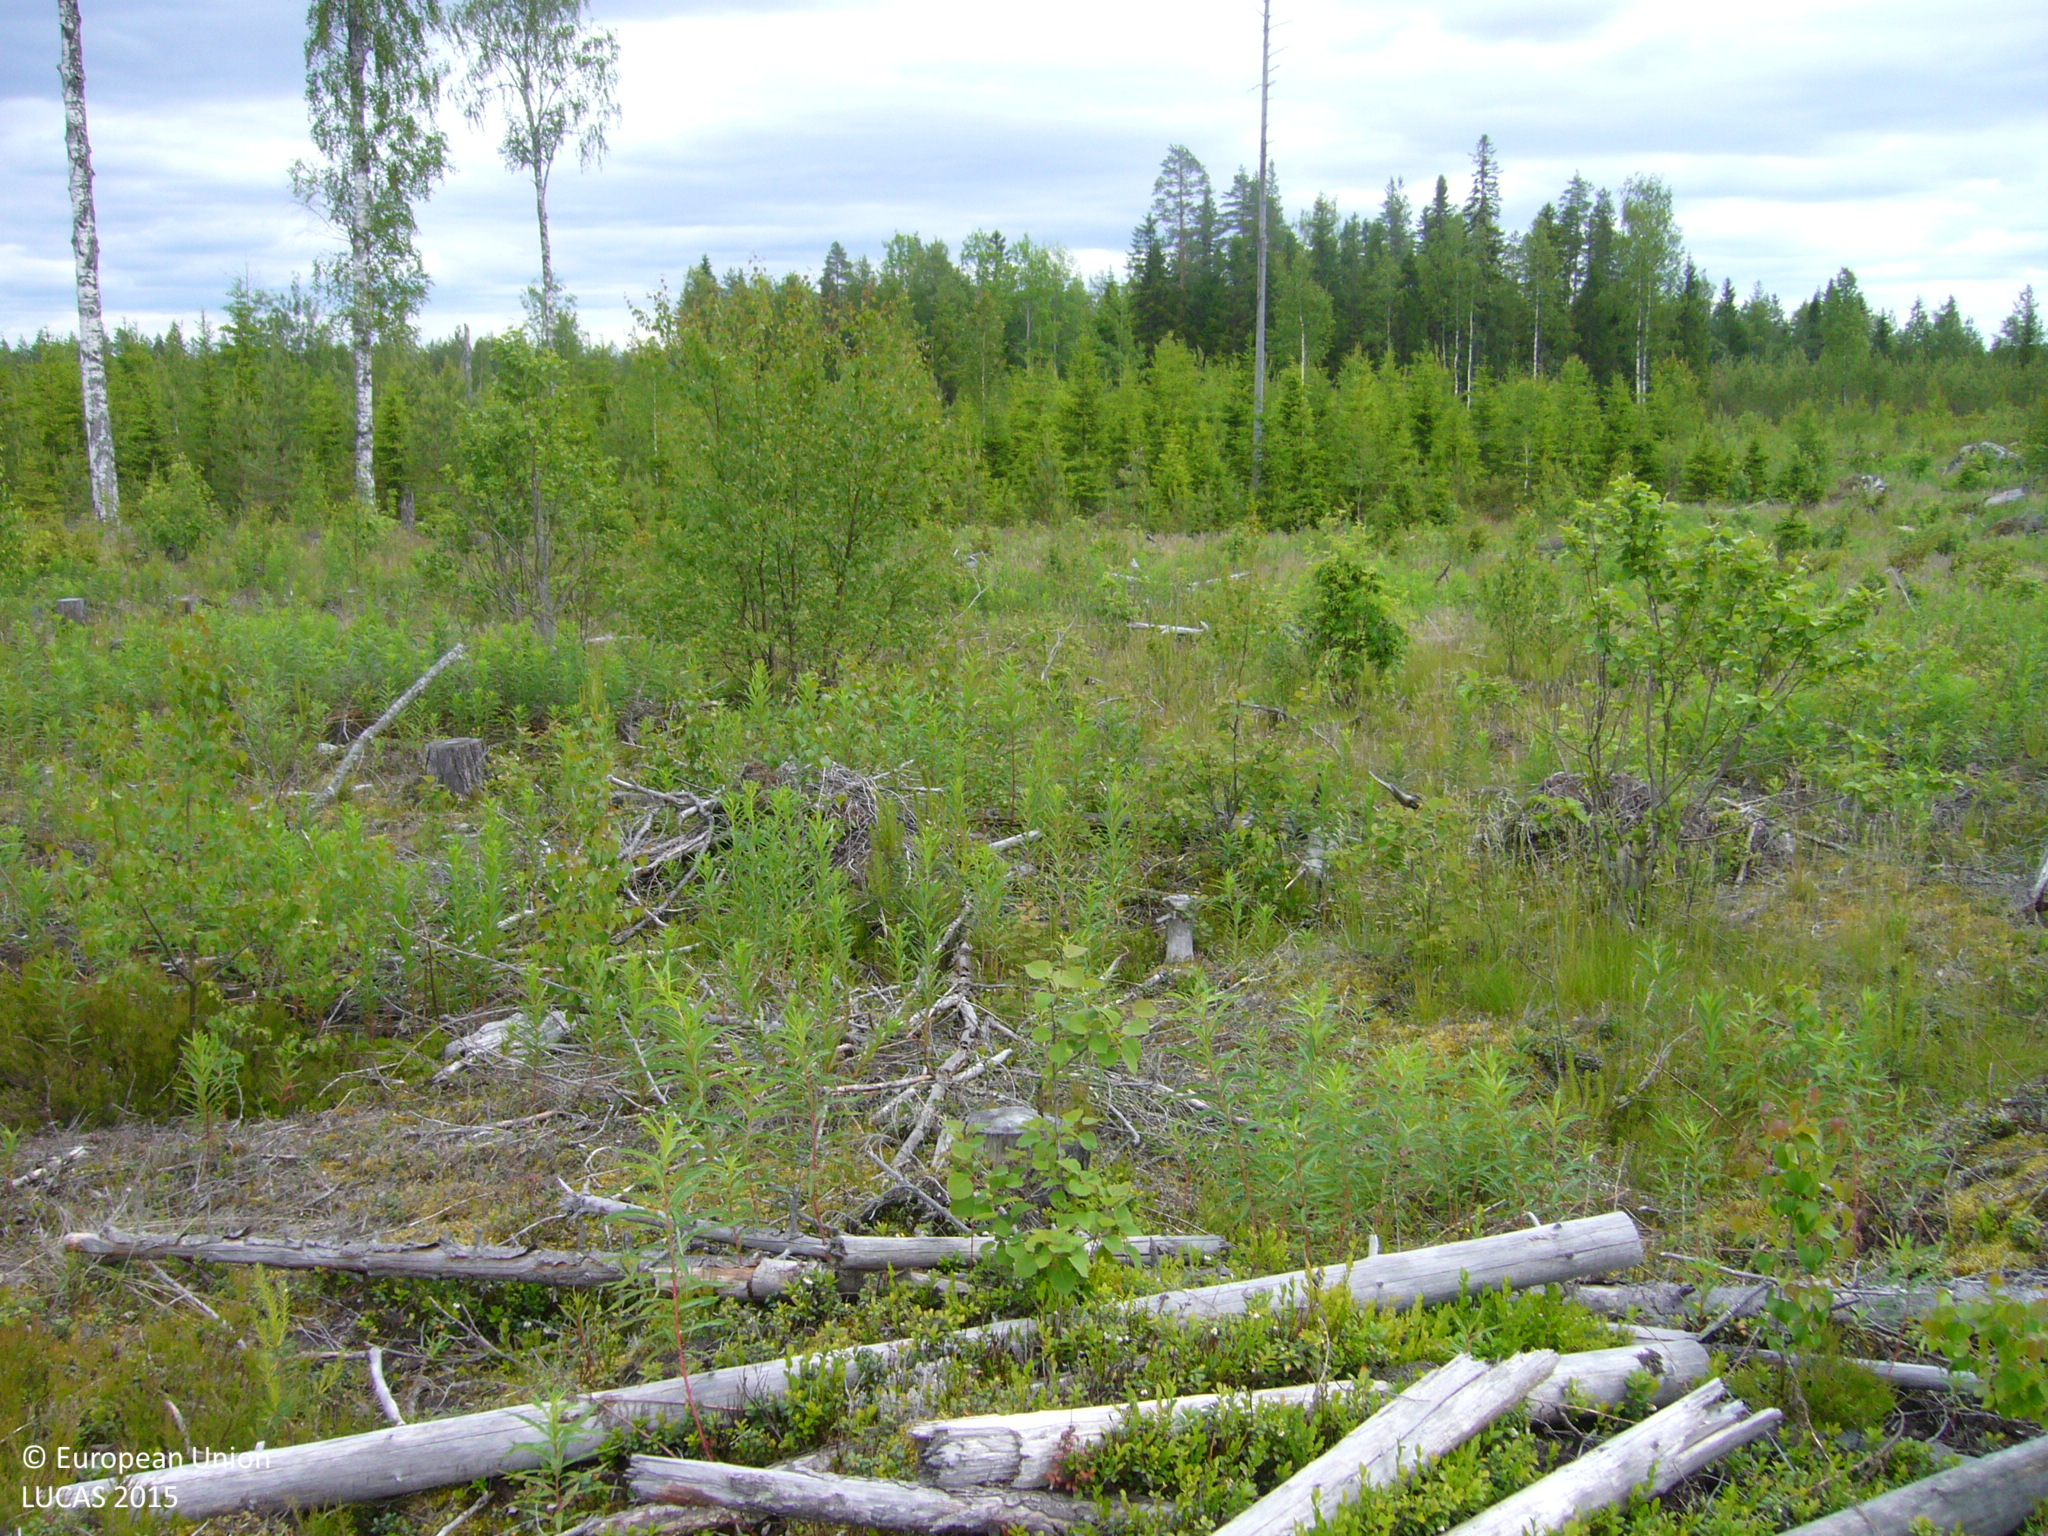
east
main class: Shrubland
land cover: Shrubland with sparse tree cover
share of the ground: > 75 %
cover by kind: shrubs 85 %, broadleaved forest trees 5 %
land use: Forestry
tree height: < 5 m
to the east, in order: Shrubland with sparse tree cover; Spruce dominated coniferous woodland; Shruby margins; Paved roads, cycling and walking lanes; Shruby margins; Spruce dominated mixed woodland; Ditches and canals; Spruce dominated mixed woodland
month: July
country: FI
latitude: 63.4133
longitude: 26.1604
